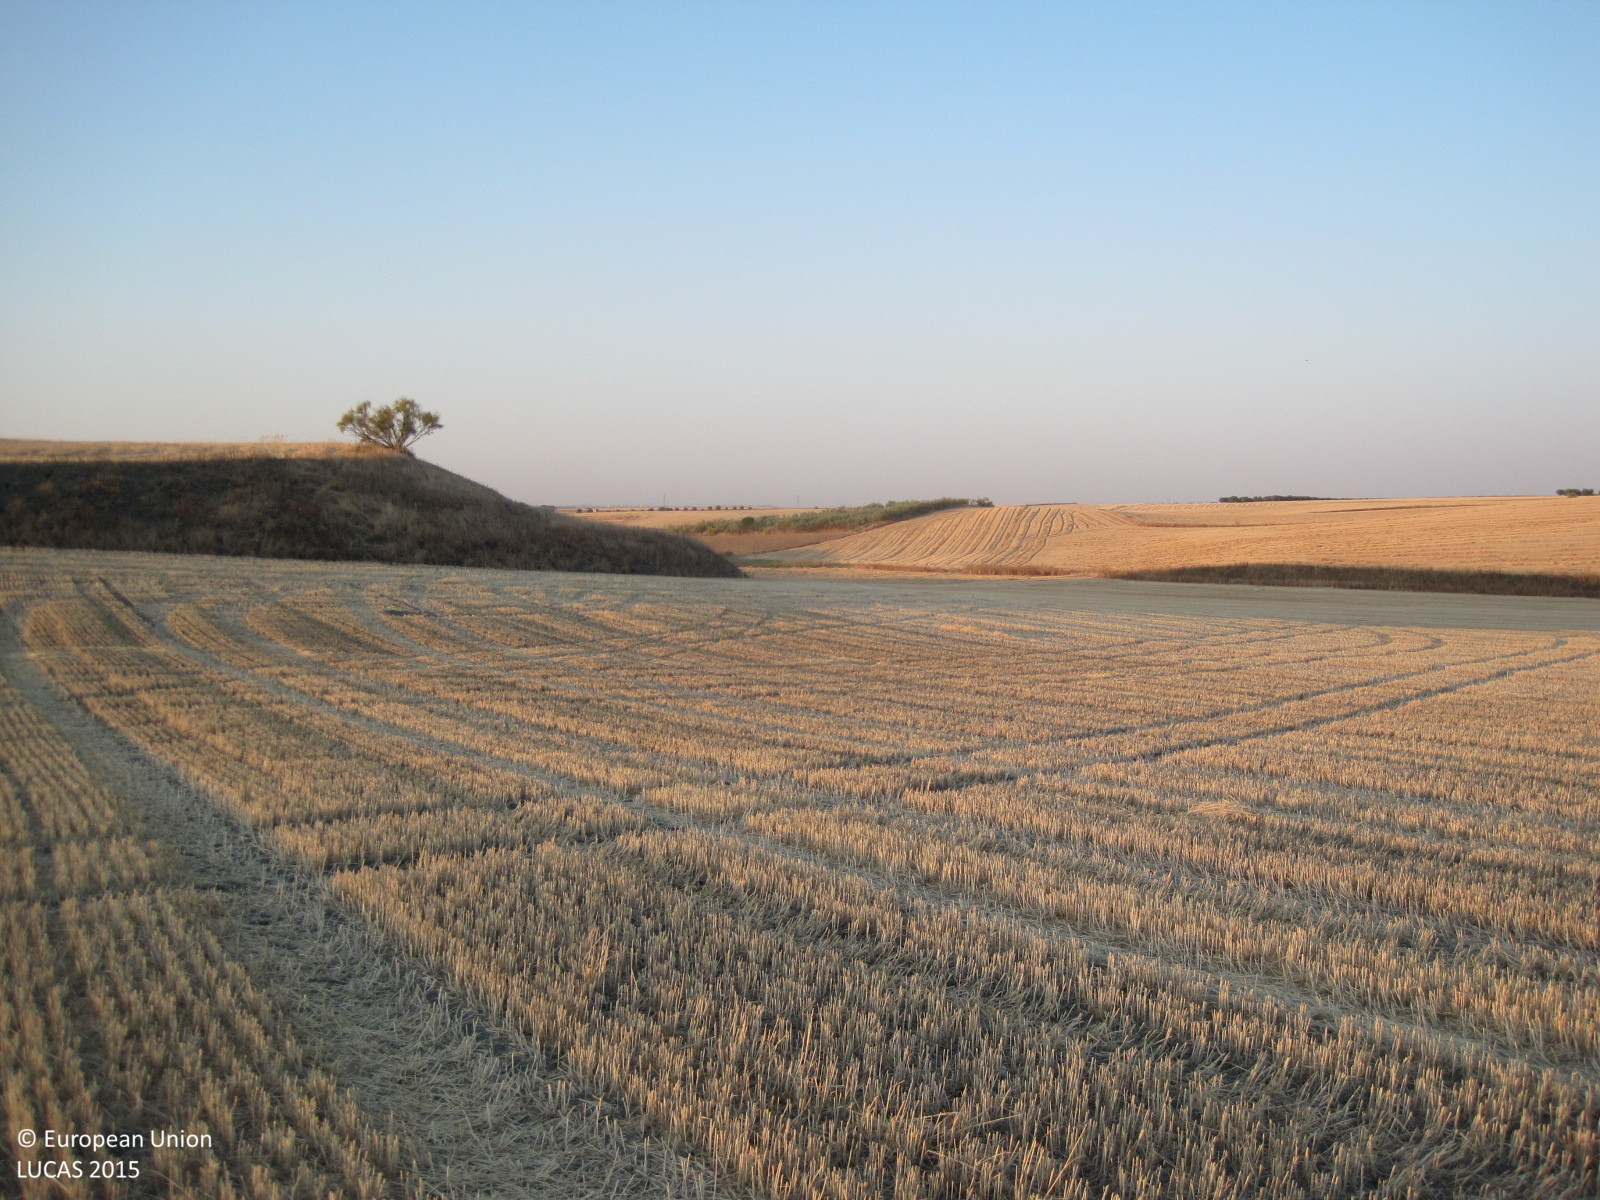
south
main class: Cropland
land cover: Barley
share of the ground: < 10 %
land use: Agriculture (excluding fallow land and kitchen gardens)
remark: Harvested field
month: July
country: ES
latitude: 40.1087
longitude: -3.8200
